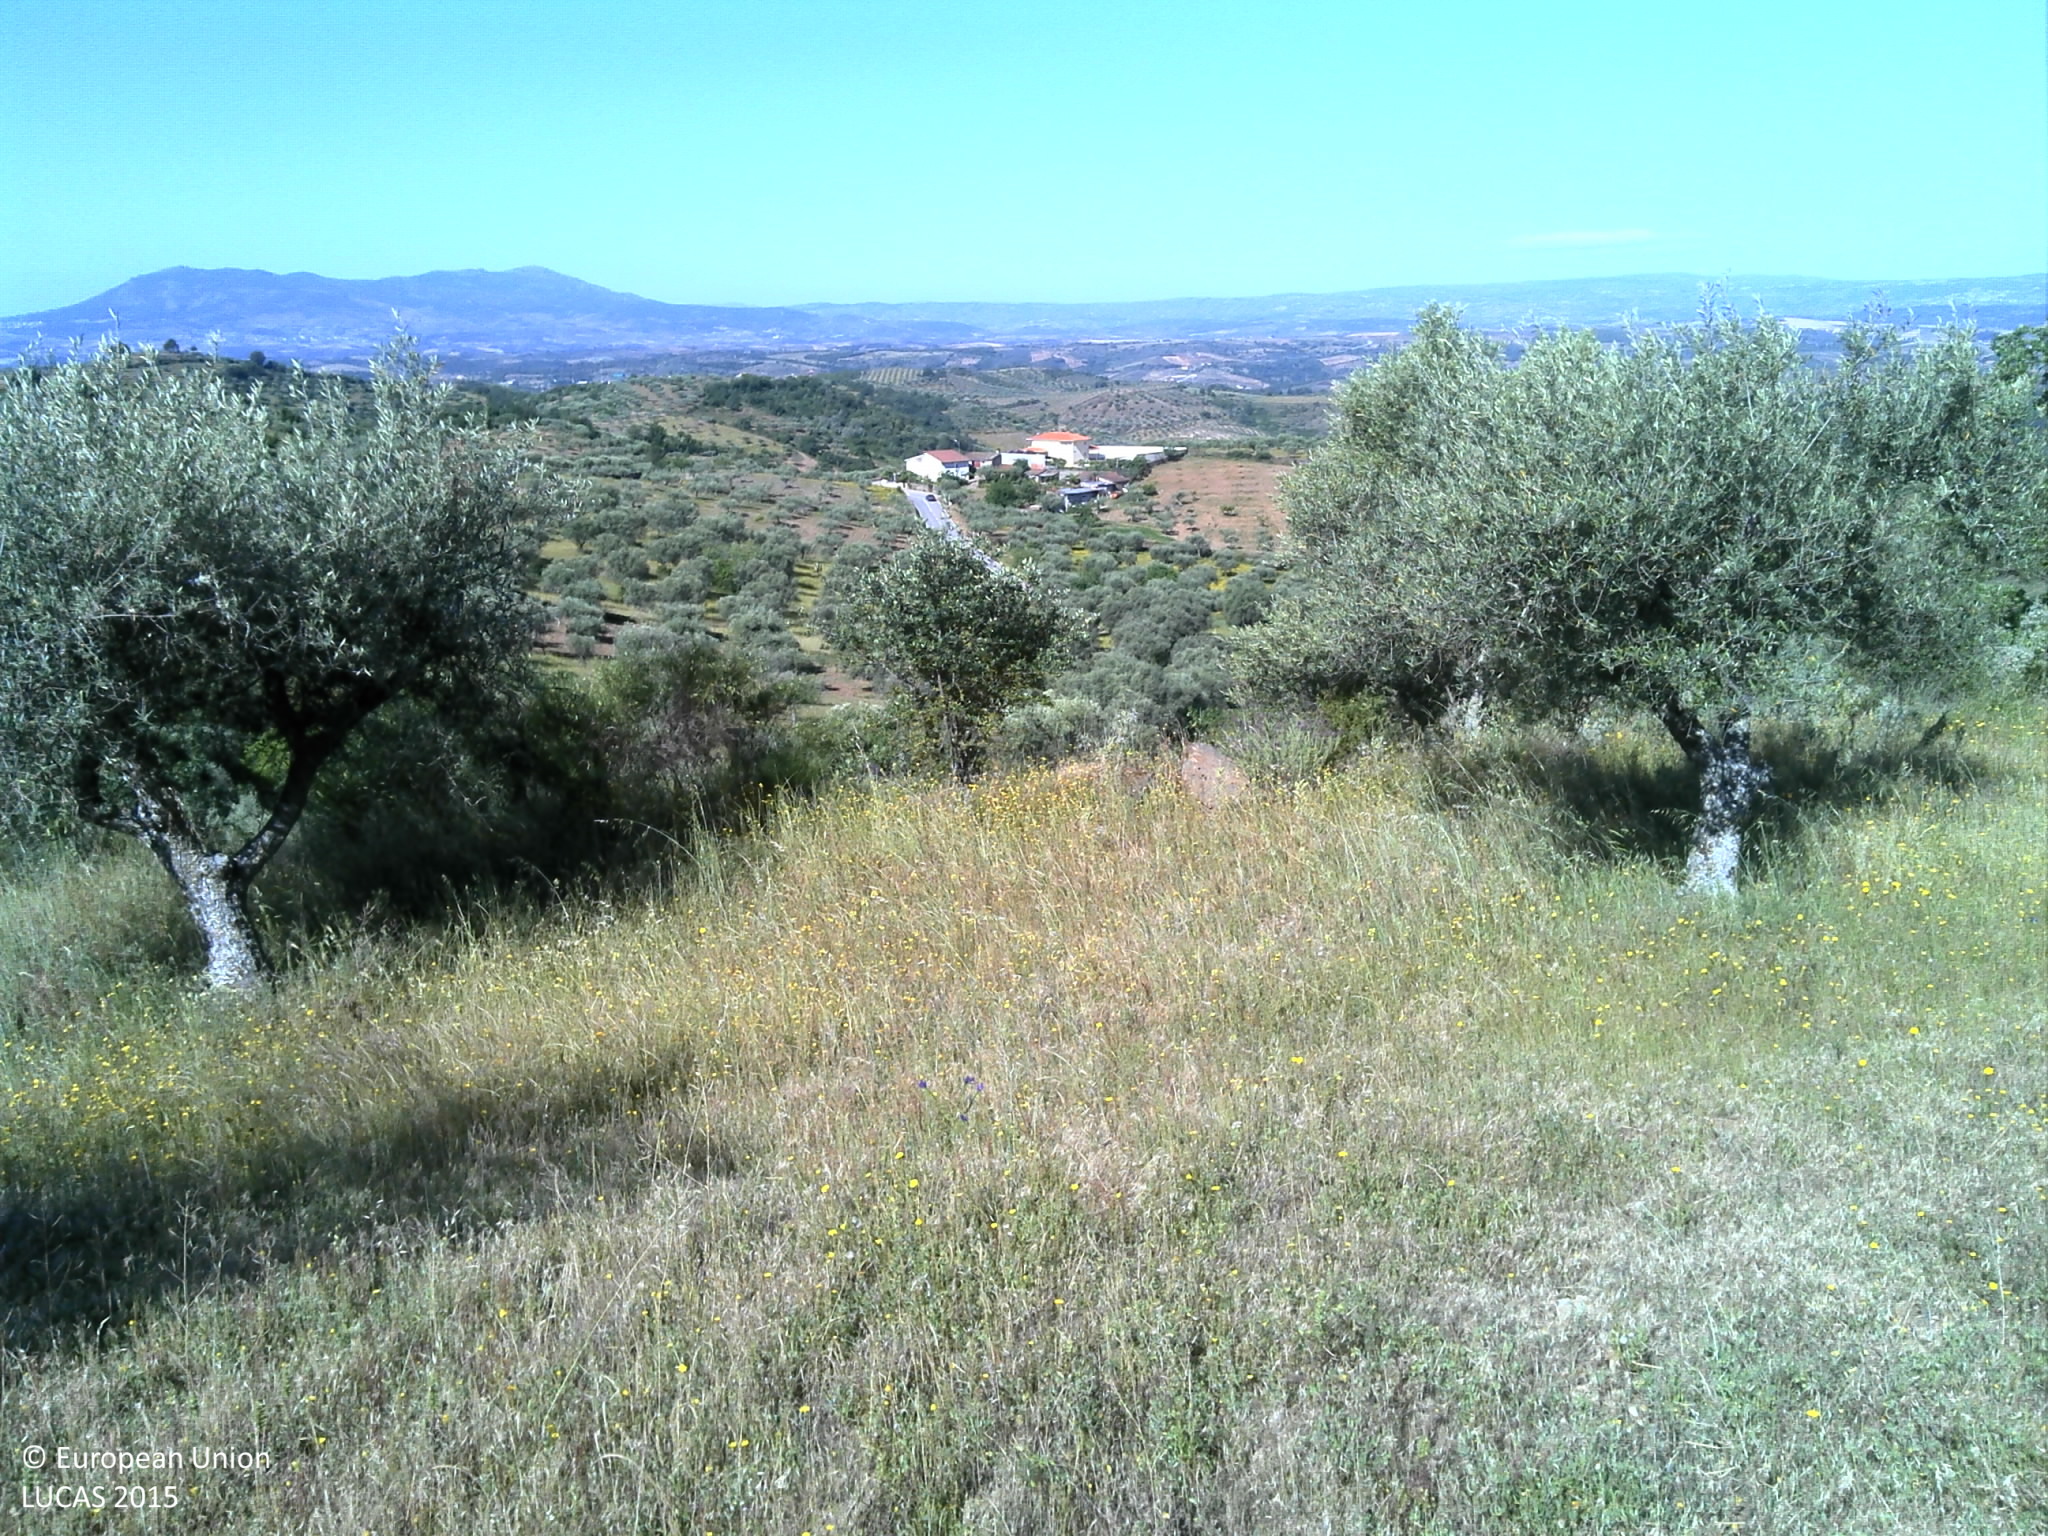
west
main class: Cropland
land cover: Olive groves
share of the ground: 25 - 50 %
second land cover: Grassland without tree/shrub cover
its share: 50 - 75 %
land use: Agriculture (excluding fallow land and kitchen gardens)
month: May
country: PT
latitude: 41.5678
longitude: -7.1356
